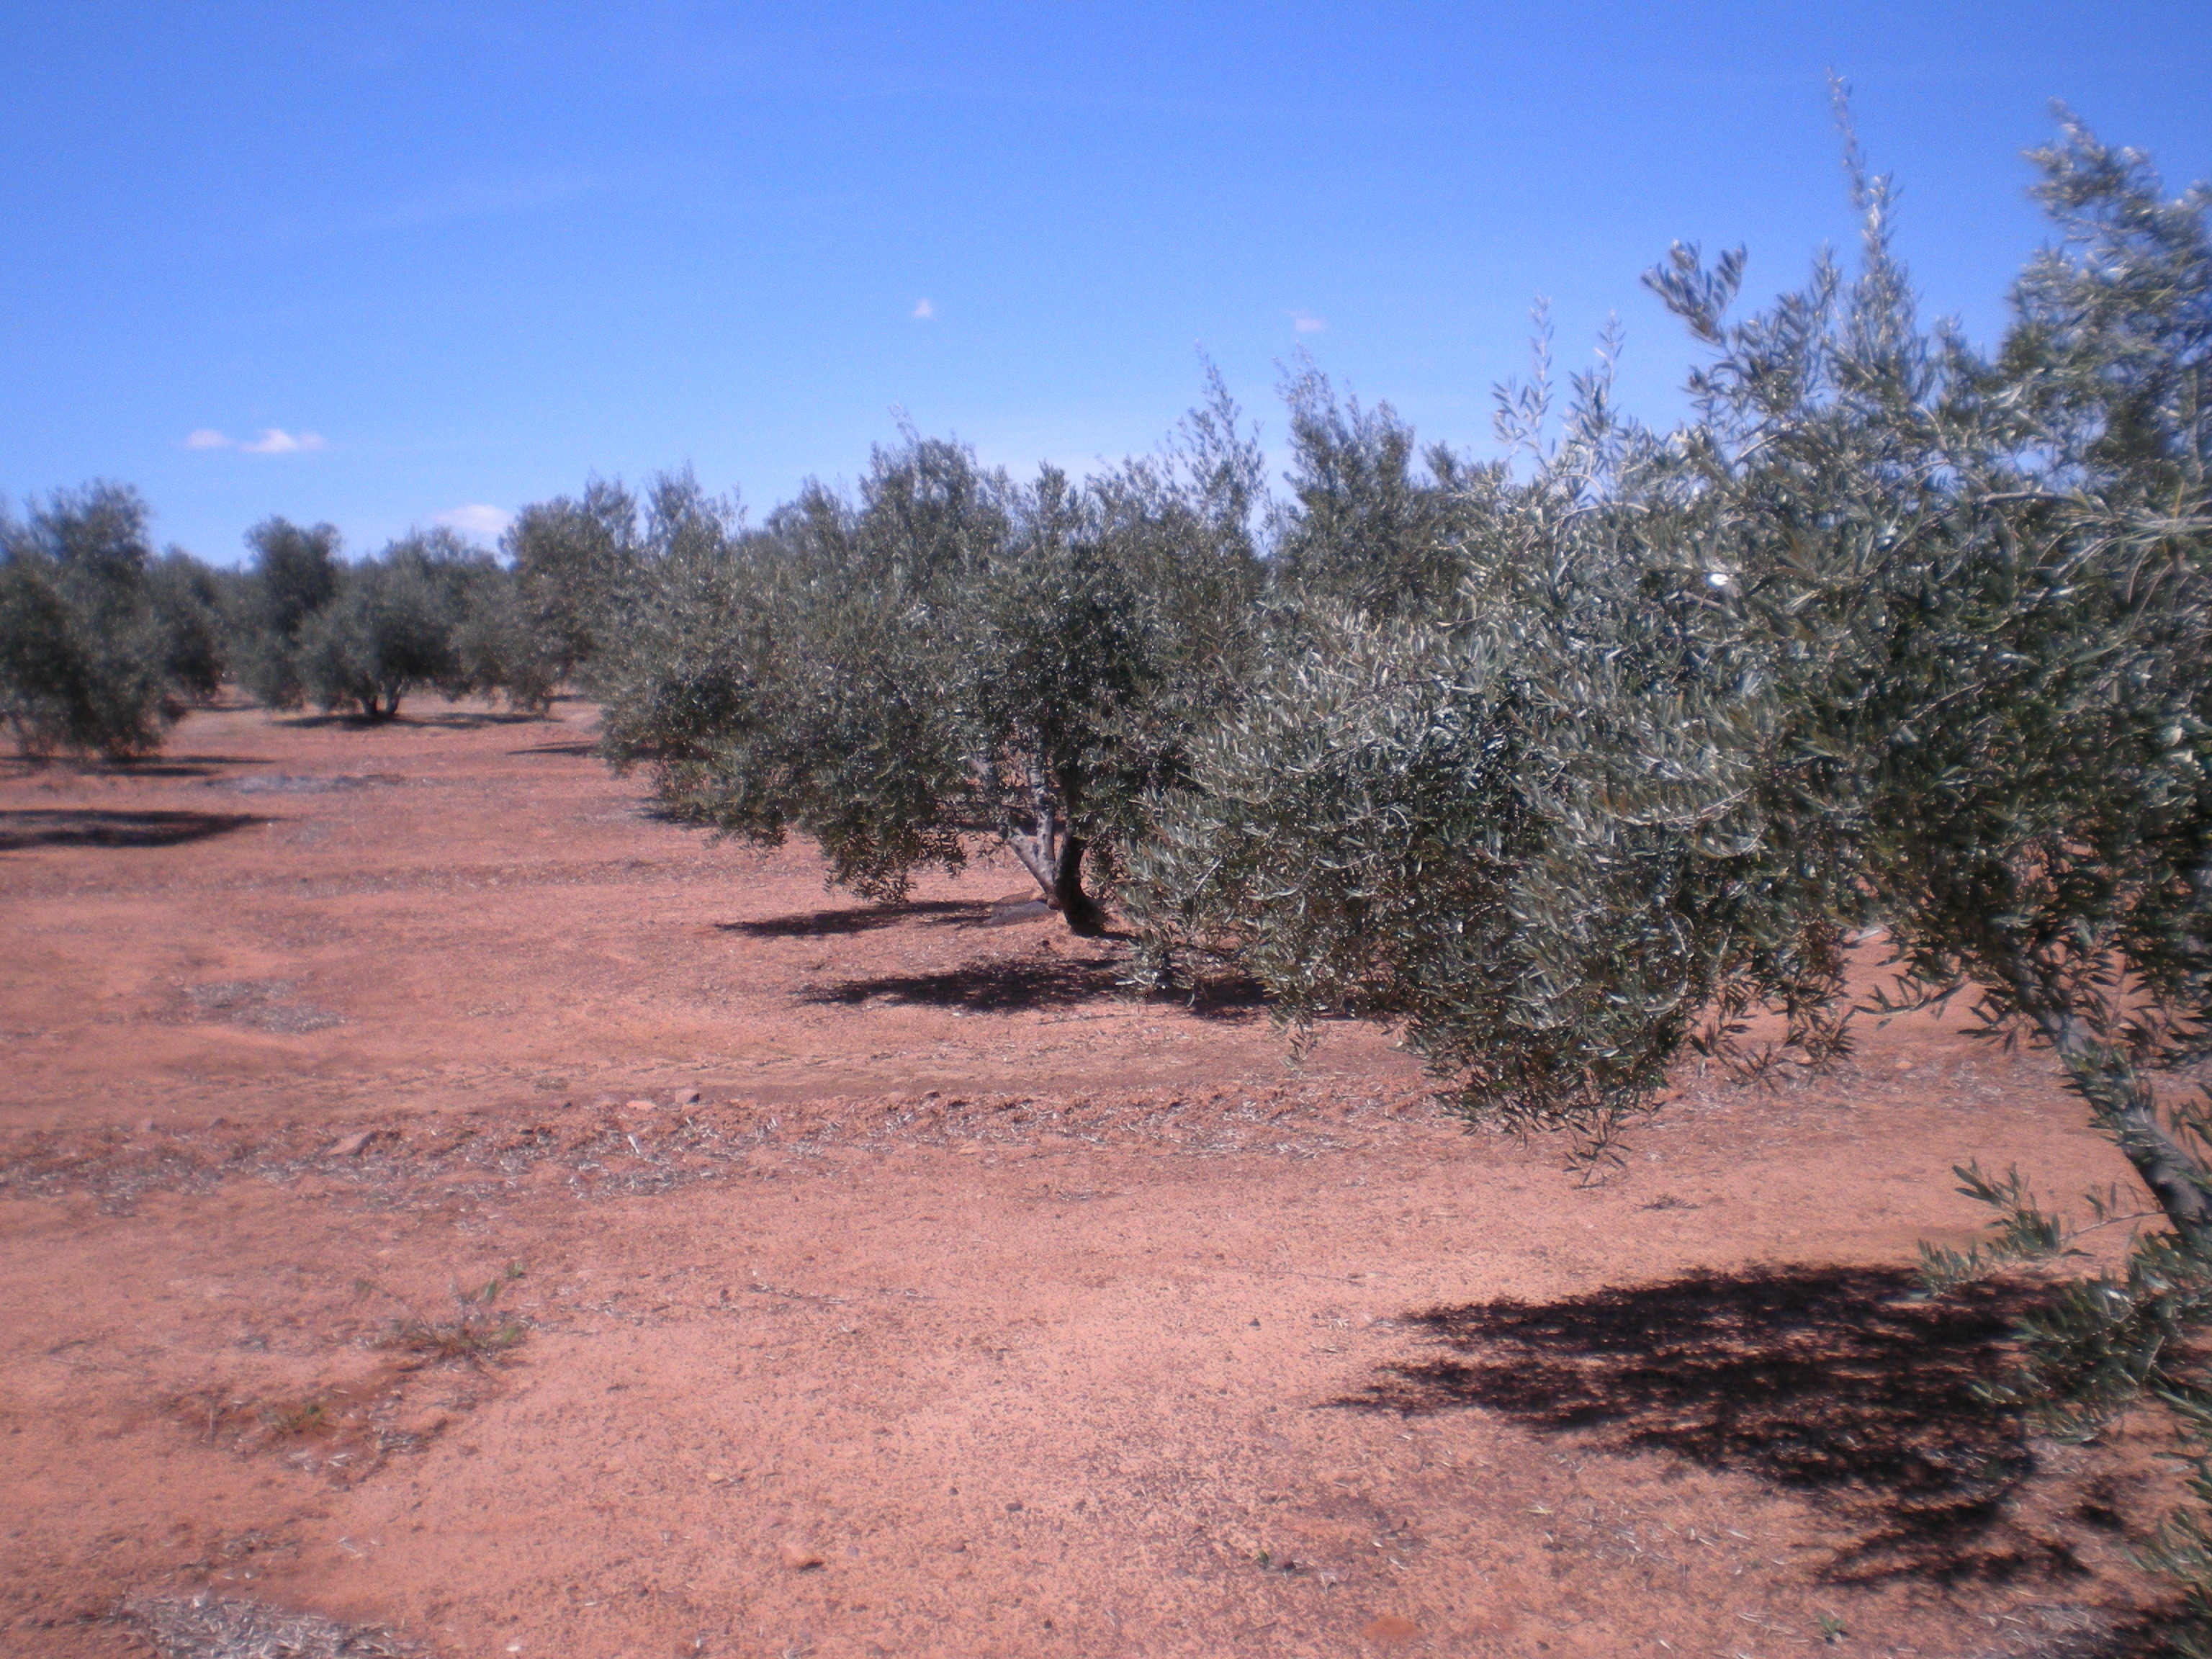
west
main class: Cropland
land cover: Olive groves
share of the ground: 25 - 50 %
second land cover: Other bare soil
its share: > 75 %
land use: Agriculture (excluding fallow land and kitchen gardens)
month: April
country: ES
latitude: 38.5436
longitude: -2.9570
